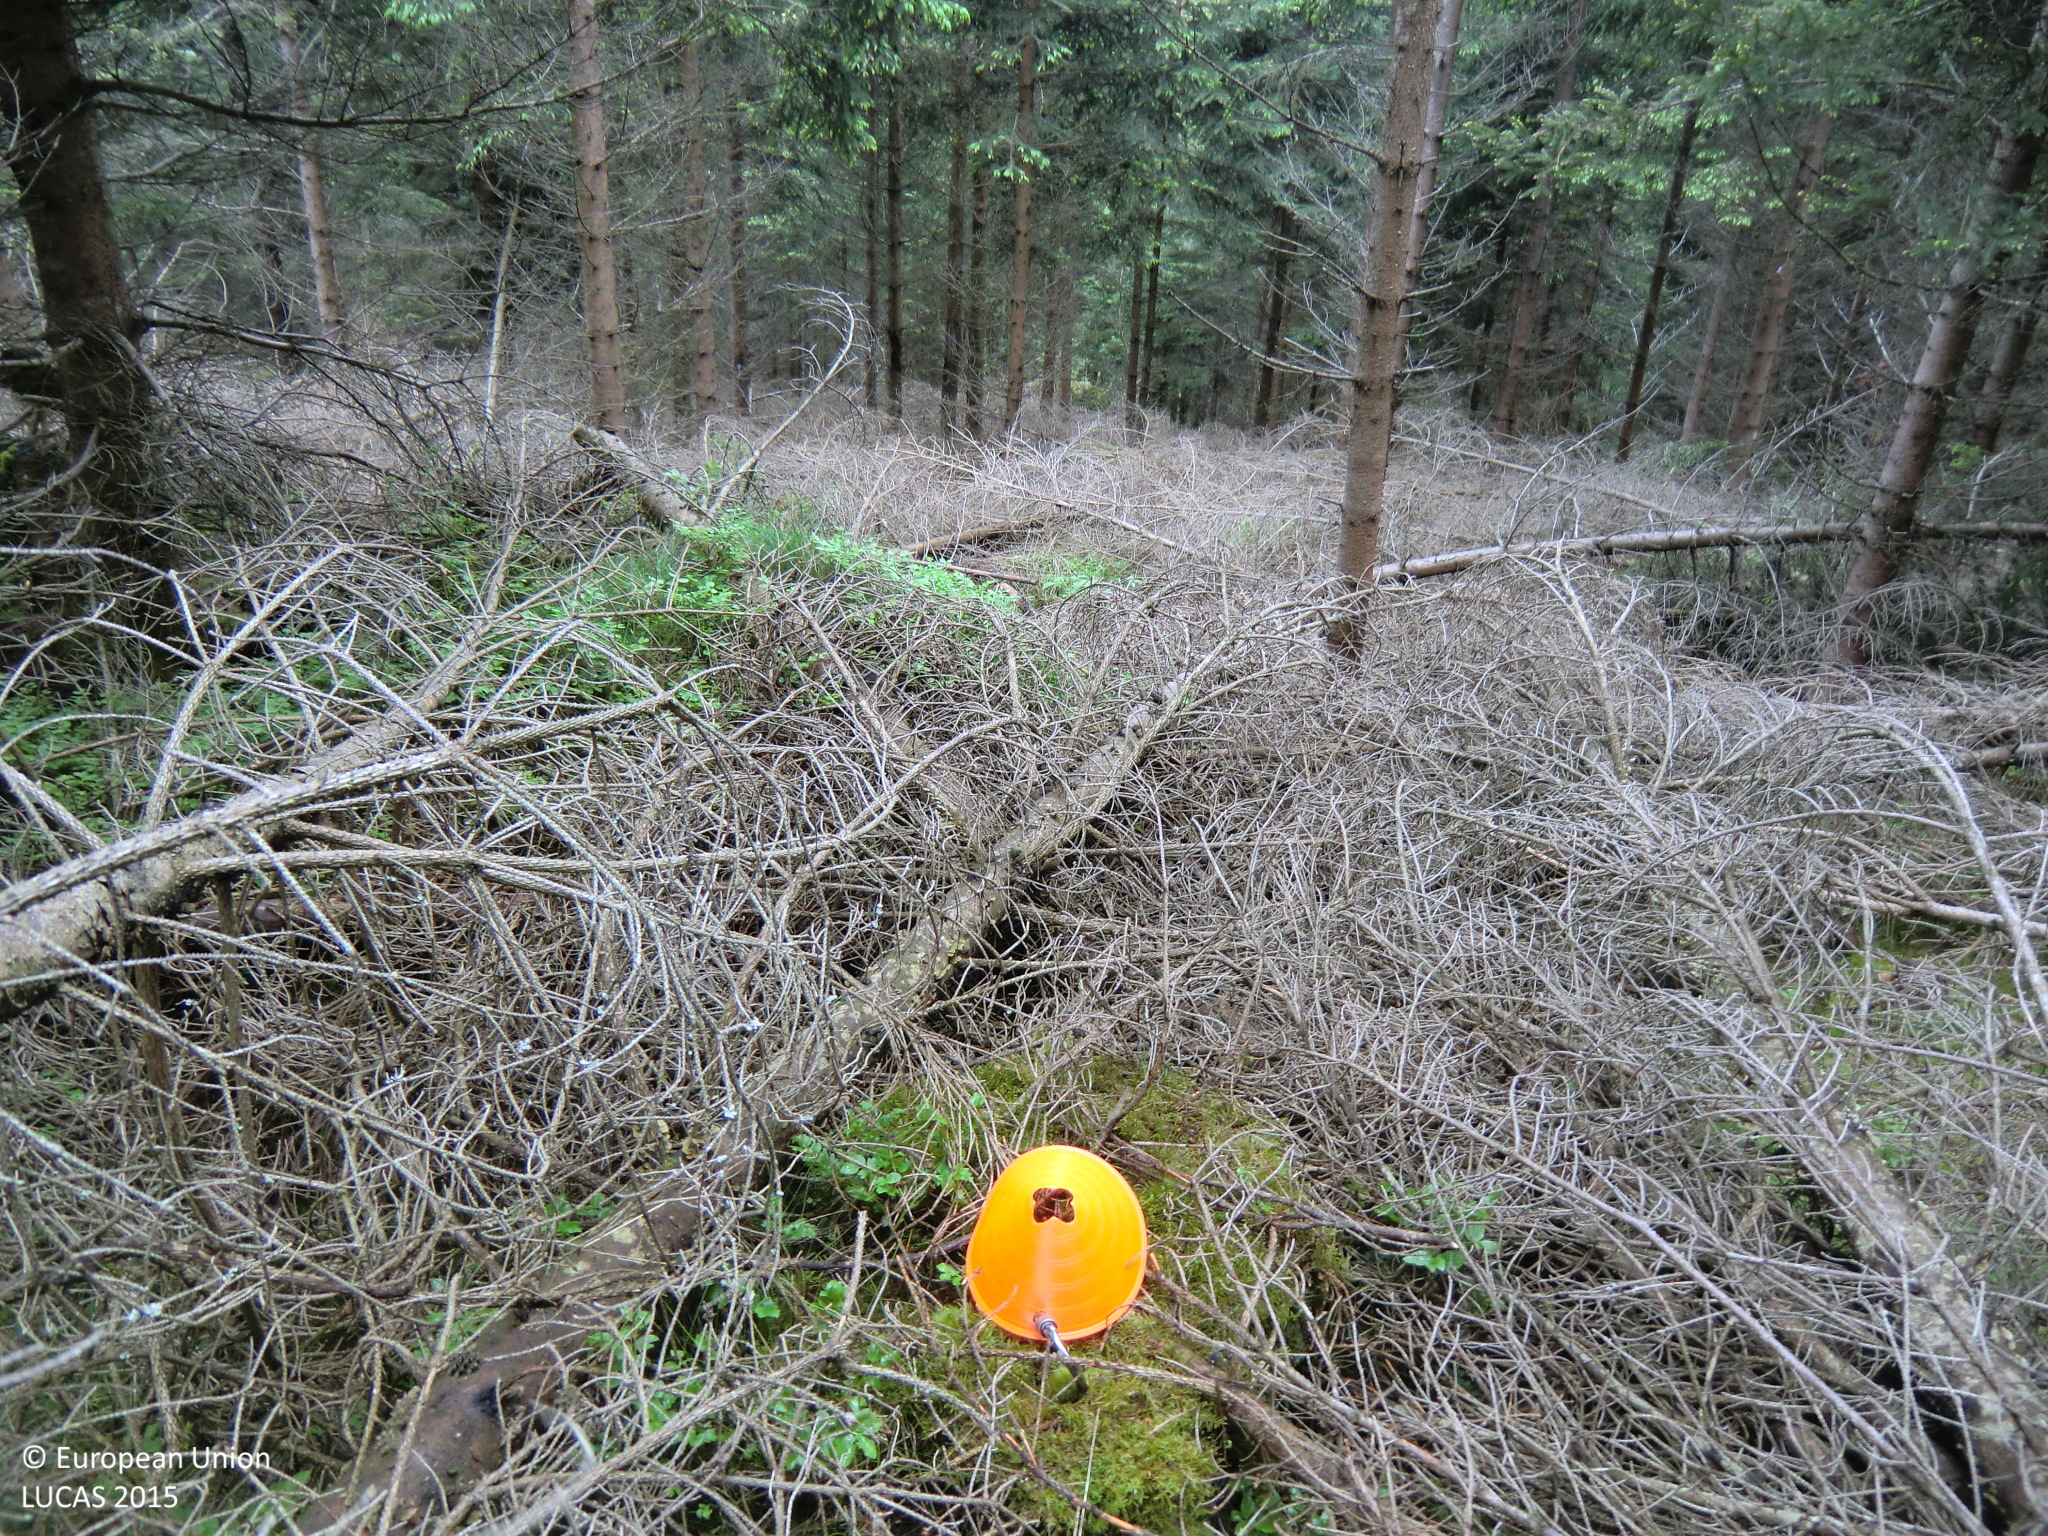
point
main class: Woodland
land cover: Spruce dominated coniferous woodland
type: hemiboreal forest and nemoral coniferous forest and mixed broadleaved-coniferous forest
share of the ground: 50 - 75 %
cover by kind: coniferous forest trees 50 %, herbaceous plants 20 %, shrubs 15 %, unconsolidated bare surface 15 %
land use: Forestry
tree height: > 5 m
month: May
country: AT
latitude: 48.3801
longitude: 15.0107
